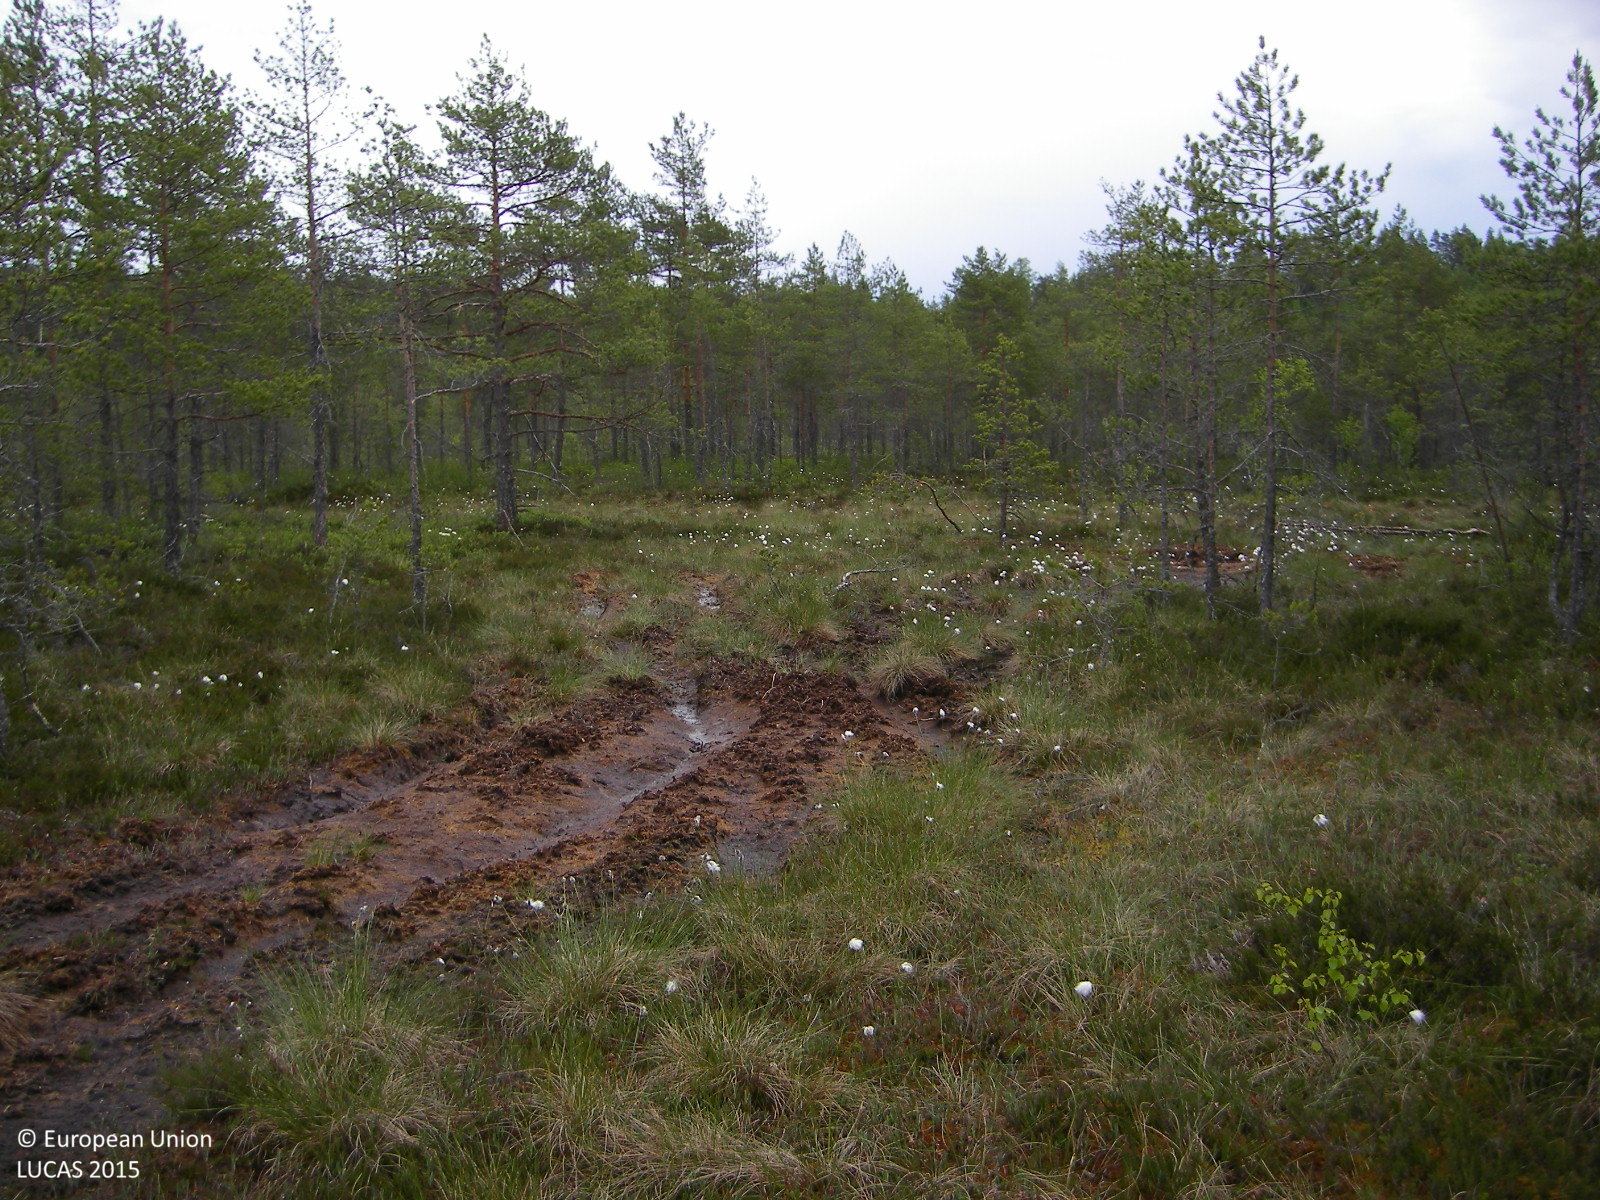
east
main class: Woodland
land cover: Pine dominated coniferous woodland
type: mire and swamp forests
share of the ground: 25 - 50 %
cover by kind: coniferous forest trees 45 %, shrubs 25 %, herbaceous plants 20 %, lichens and mosses 5 %, unconsolidated bare surface 5 %
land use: Semi-natural and natural areas not in use
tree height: < 5 m
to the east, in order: Pine dominated coniferous woodland; Peatbogs; Other mixed woodland; Broadleaved woodland
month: June
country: FI
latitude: 60.3976
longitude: 24.6842
